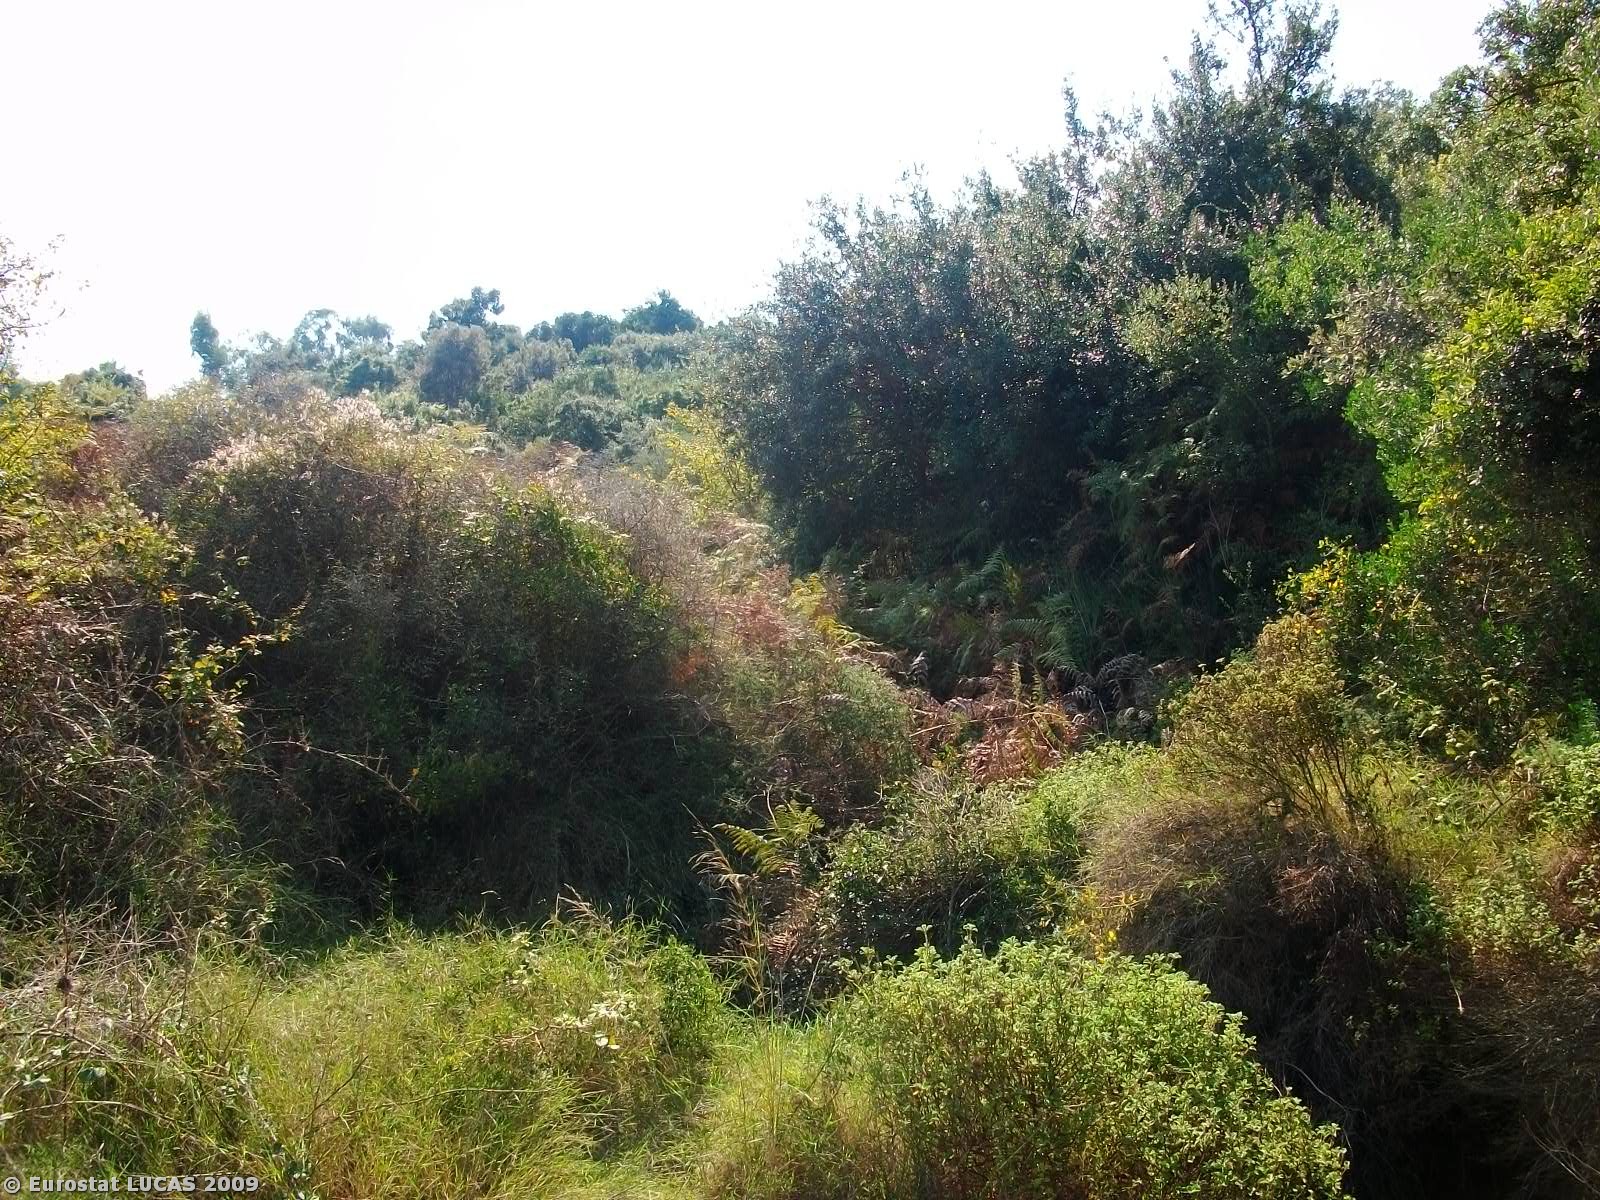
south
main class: Grassland
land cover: Grassland with sparse tree/shrub cover
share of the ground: > 75 %
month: September
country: GR
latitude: 37.7562
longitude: 21.3893
